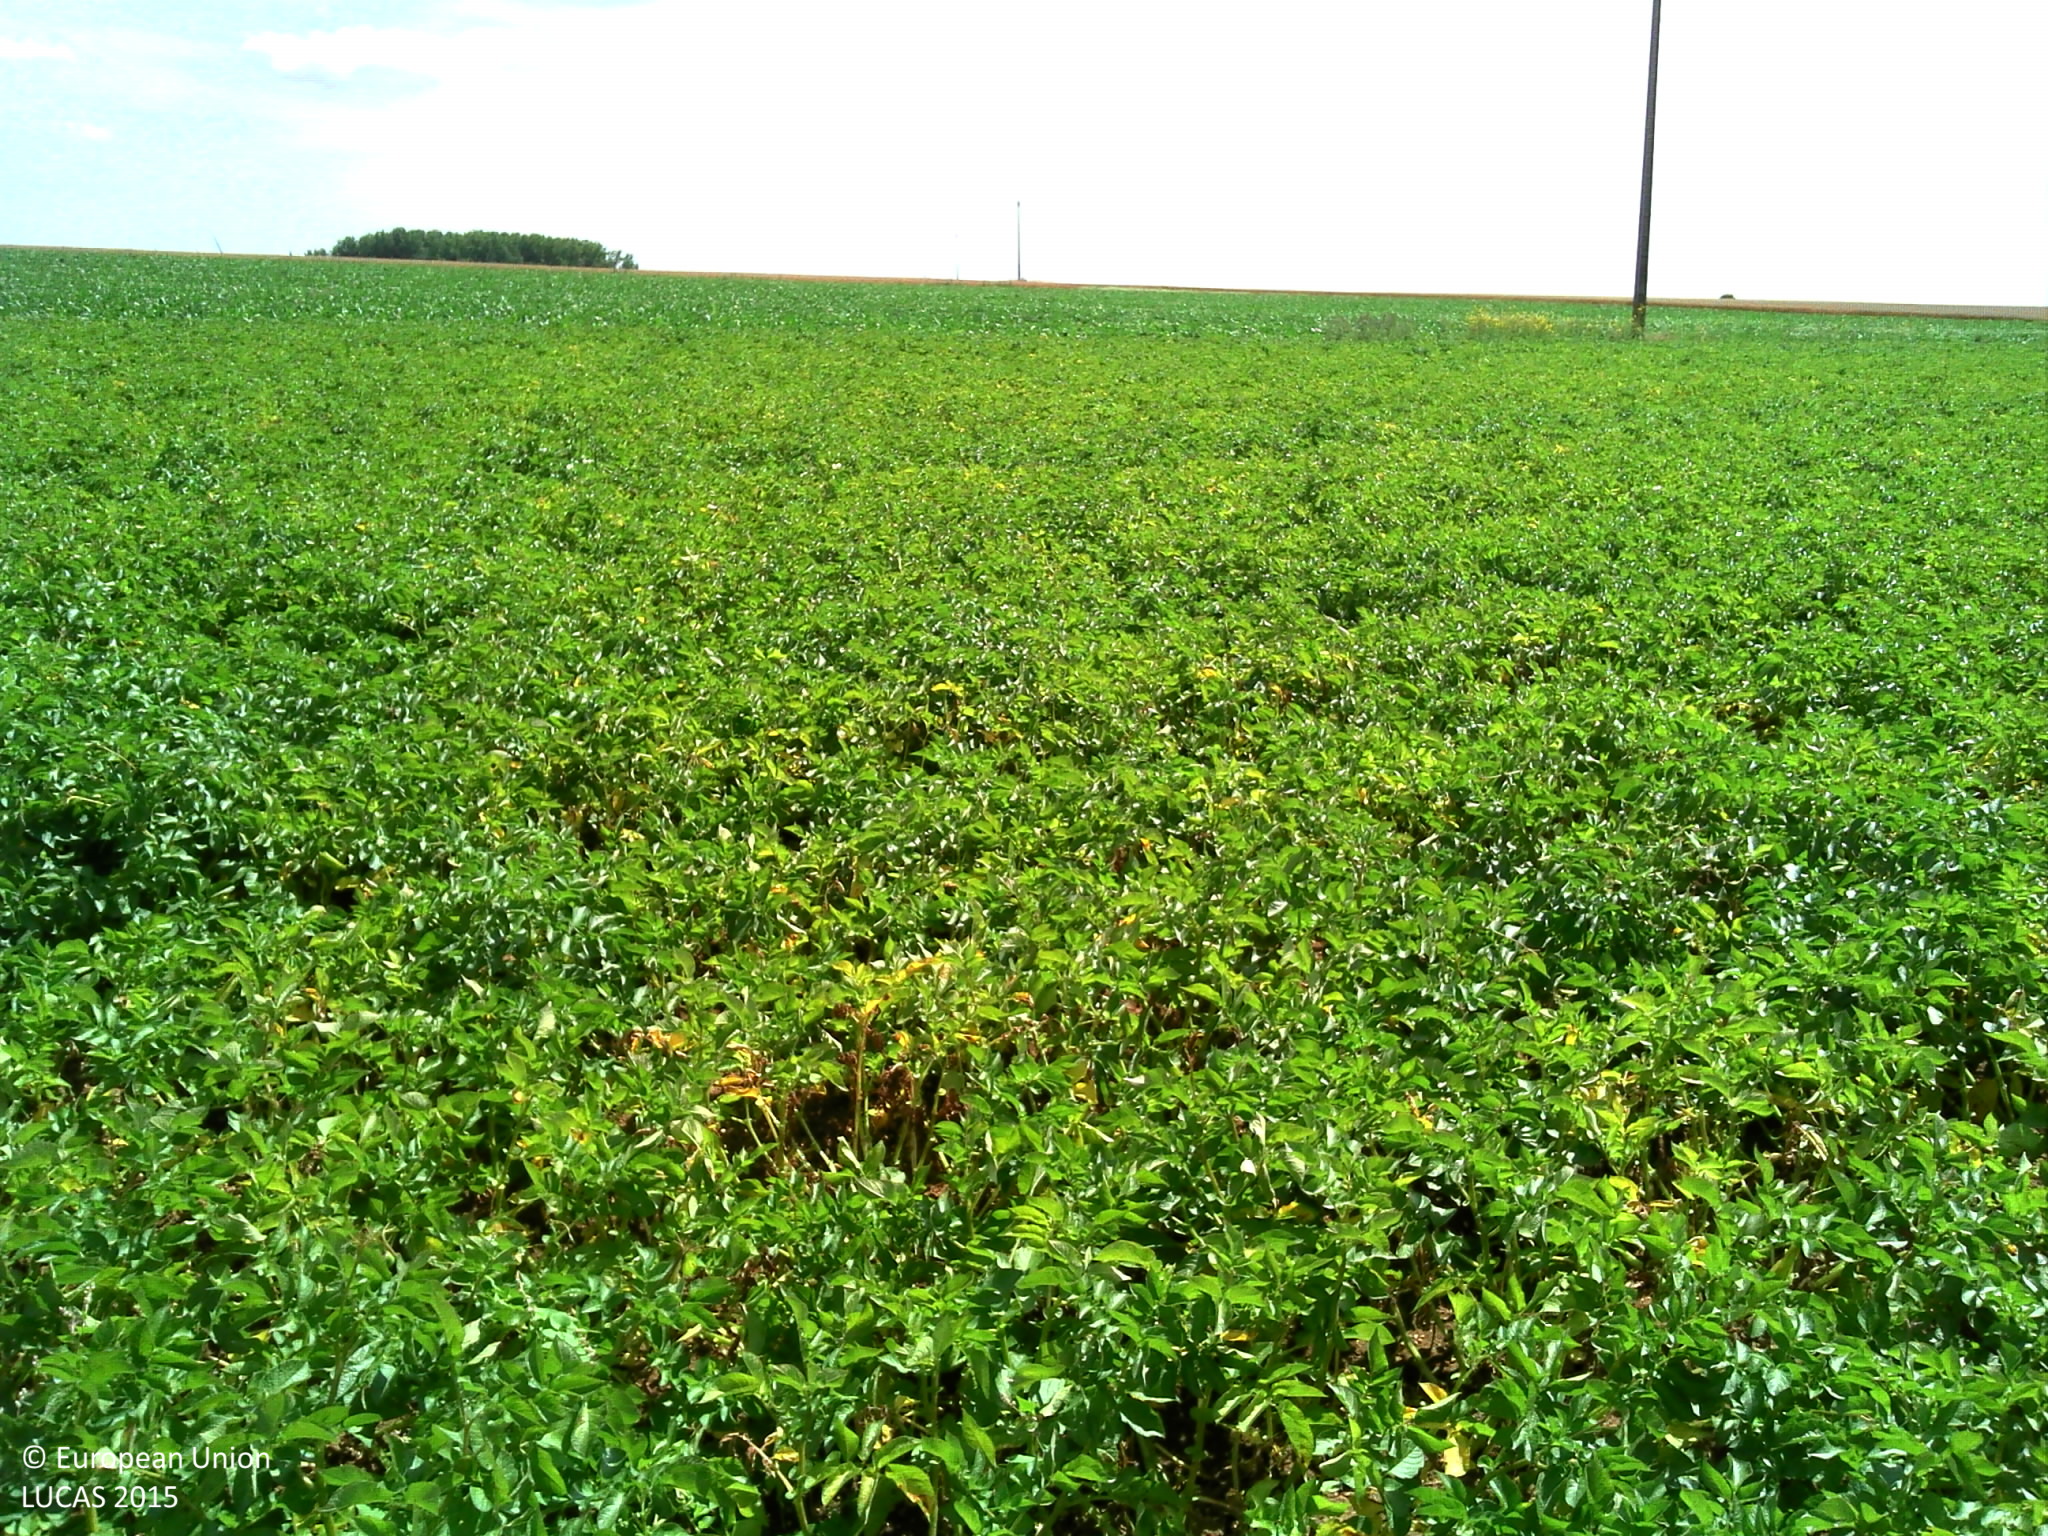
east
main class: Cropland
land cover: Potatoes
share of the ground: > 75 %
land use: Agriculture (excluding fallow land and kitchen gardens)
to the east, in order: Potatoes; Sugar beet; Electric lines; Sugar beet; Common wheat
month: July
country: FR
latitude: 50.1557
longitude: 2.8090
